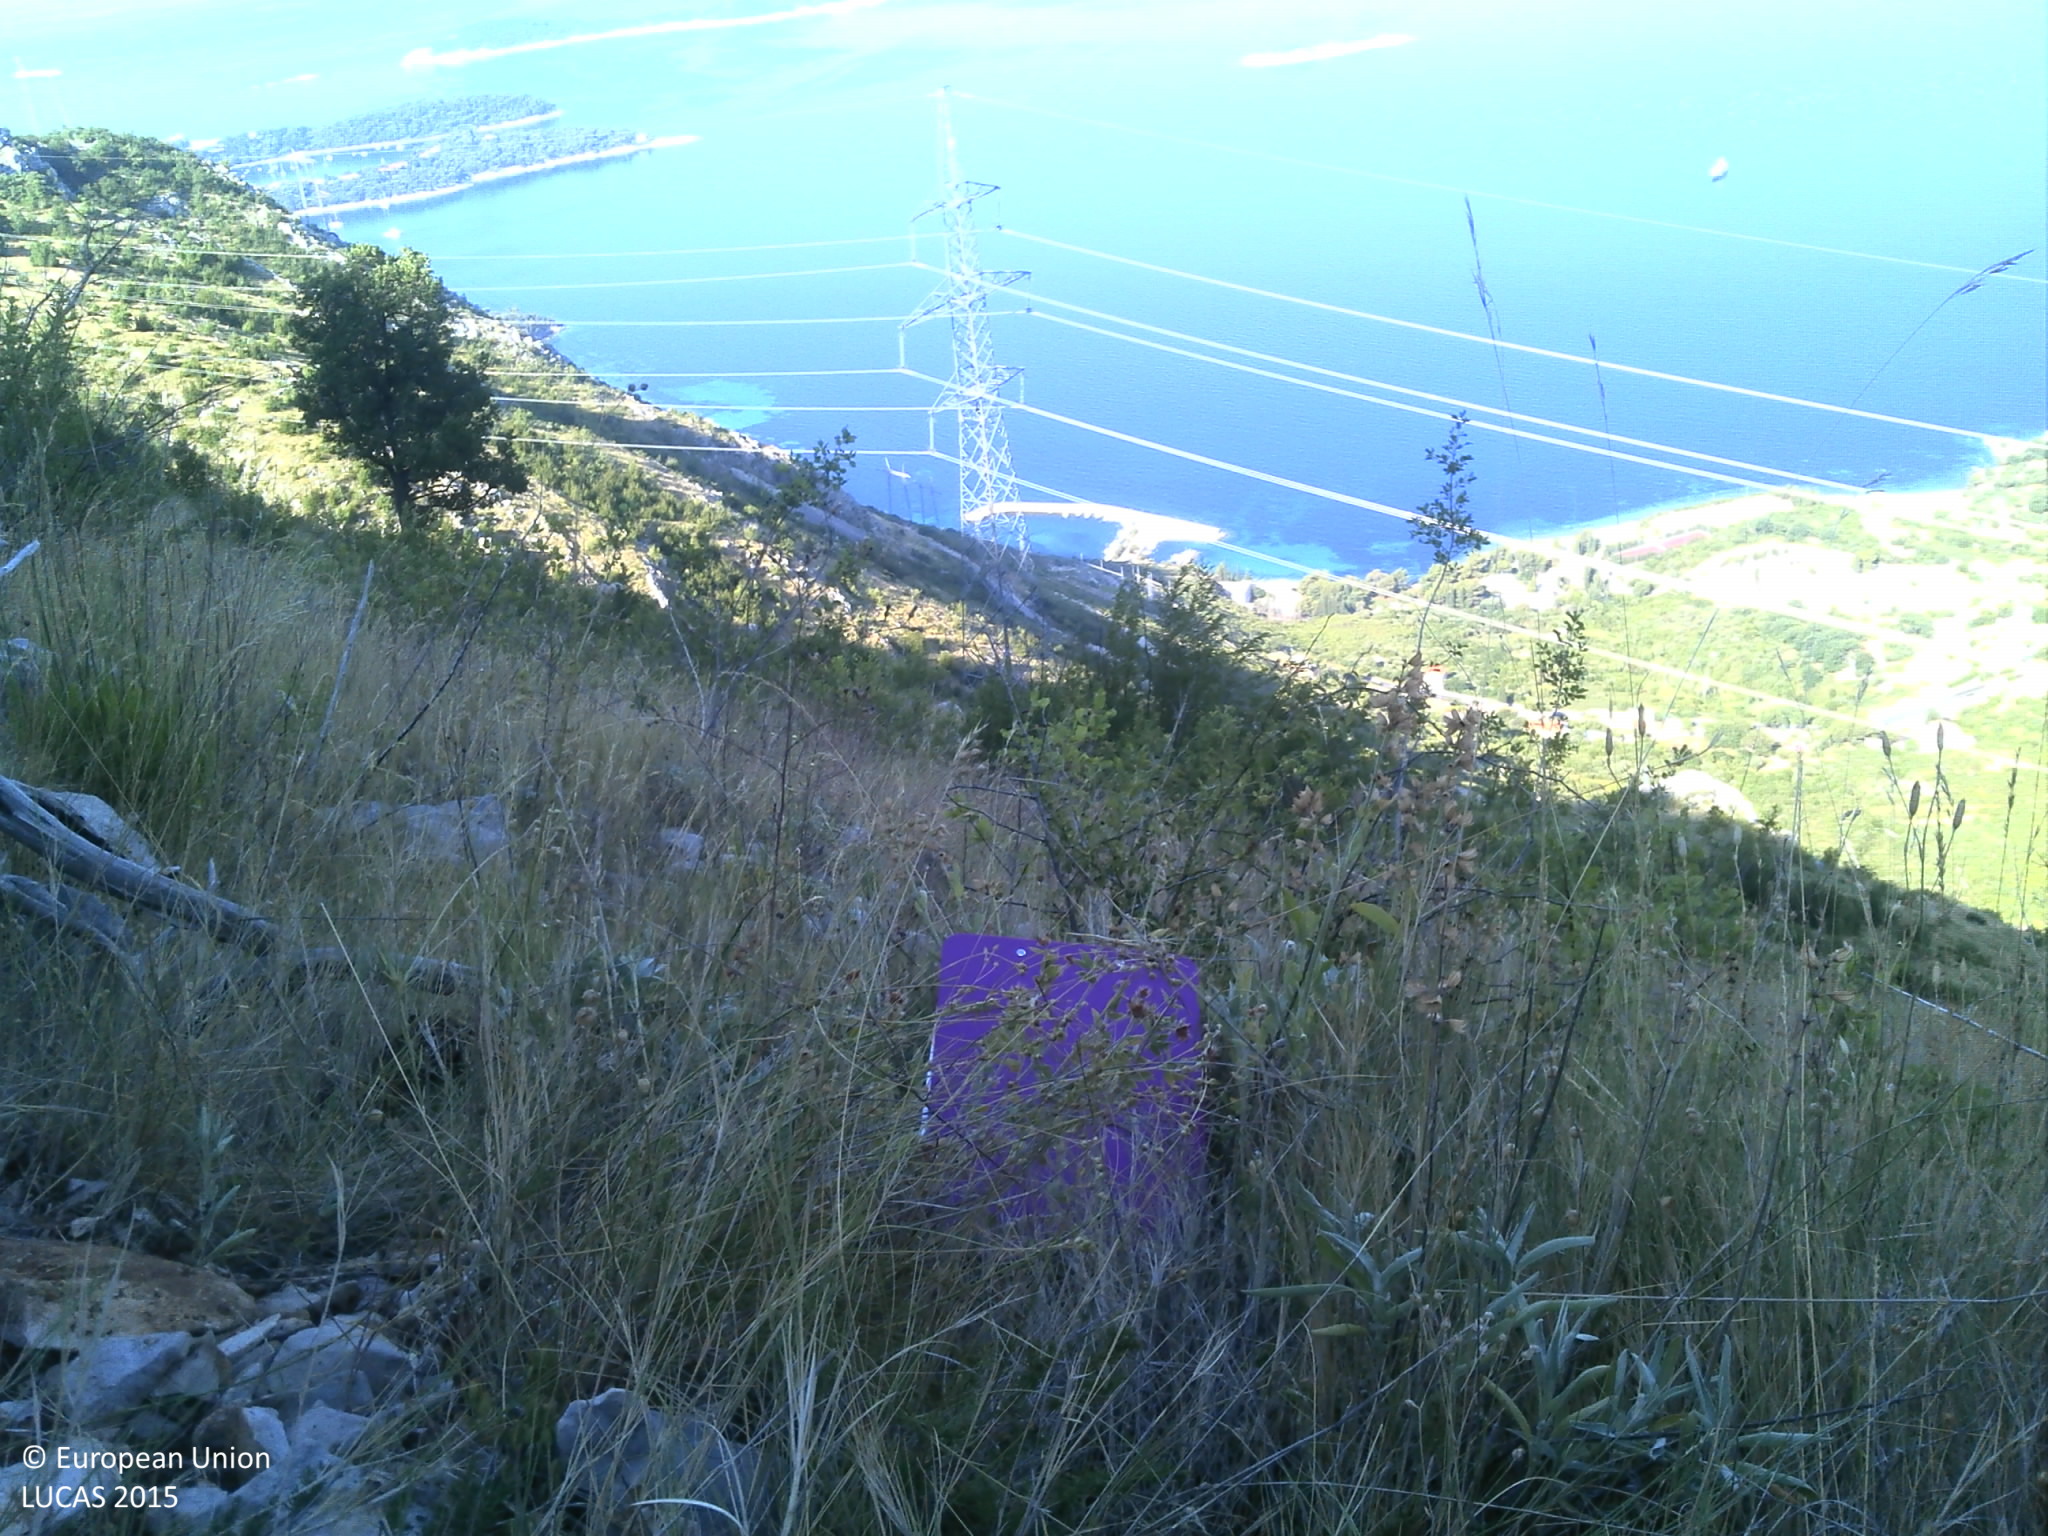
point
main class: Shrubland
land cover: Shrubland with sparse tree cover
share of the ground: 25 - 50 %
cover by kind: herbaceous plants 40 %, unconsolidated bare surface 30 %, shrubs 25 %, broadleaved forest trees 5 %
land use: Semi-natural and natural areas not in use
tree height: < 5 m
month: July
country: HR
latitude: 42.6079
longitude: 18.2428
